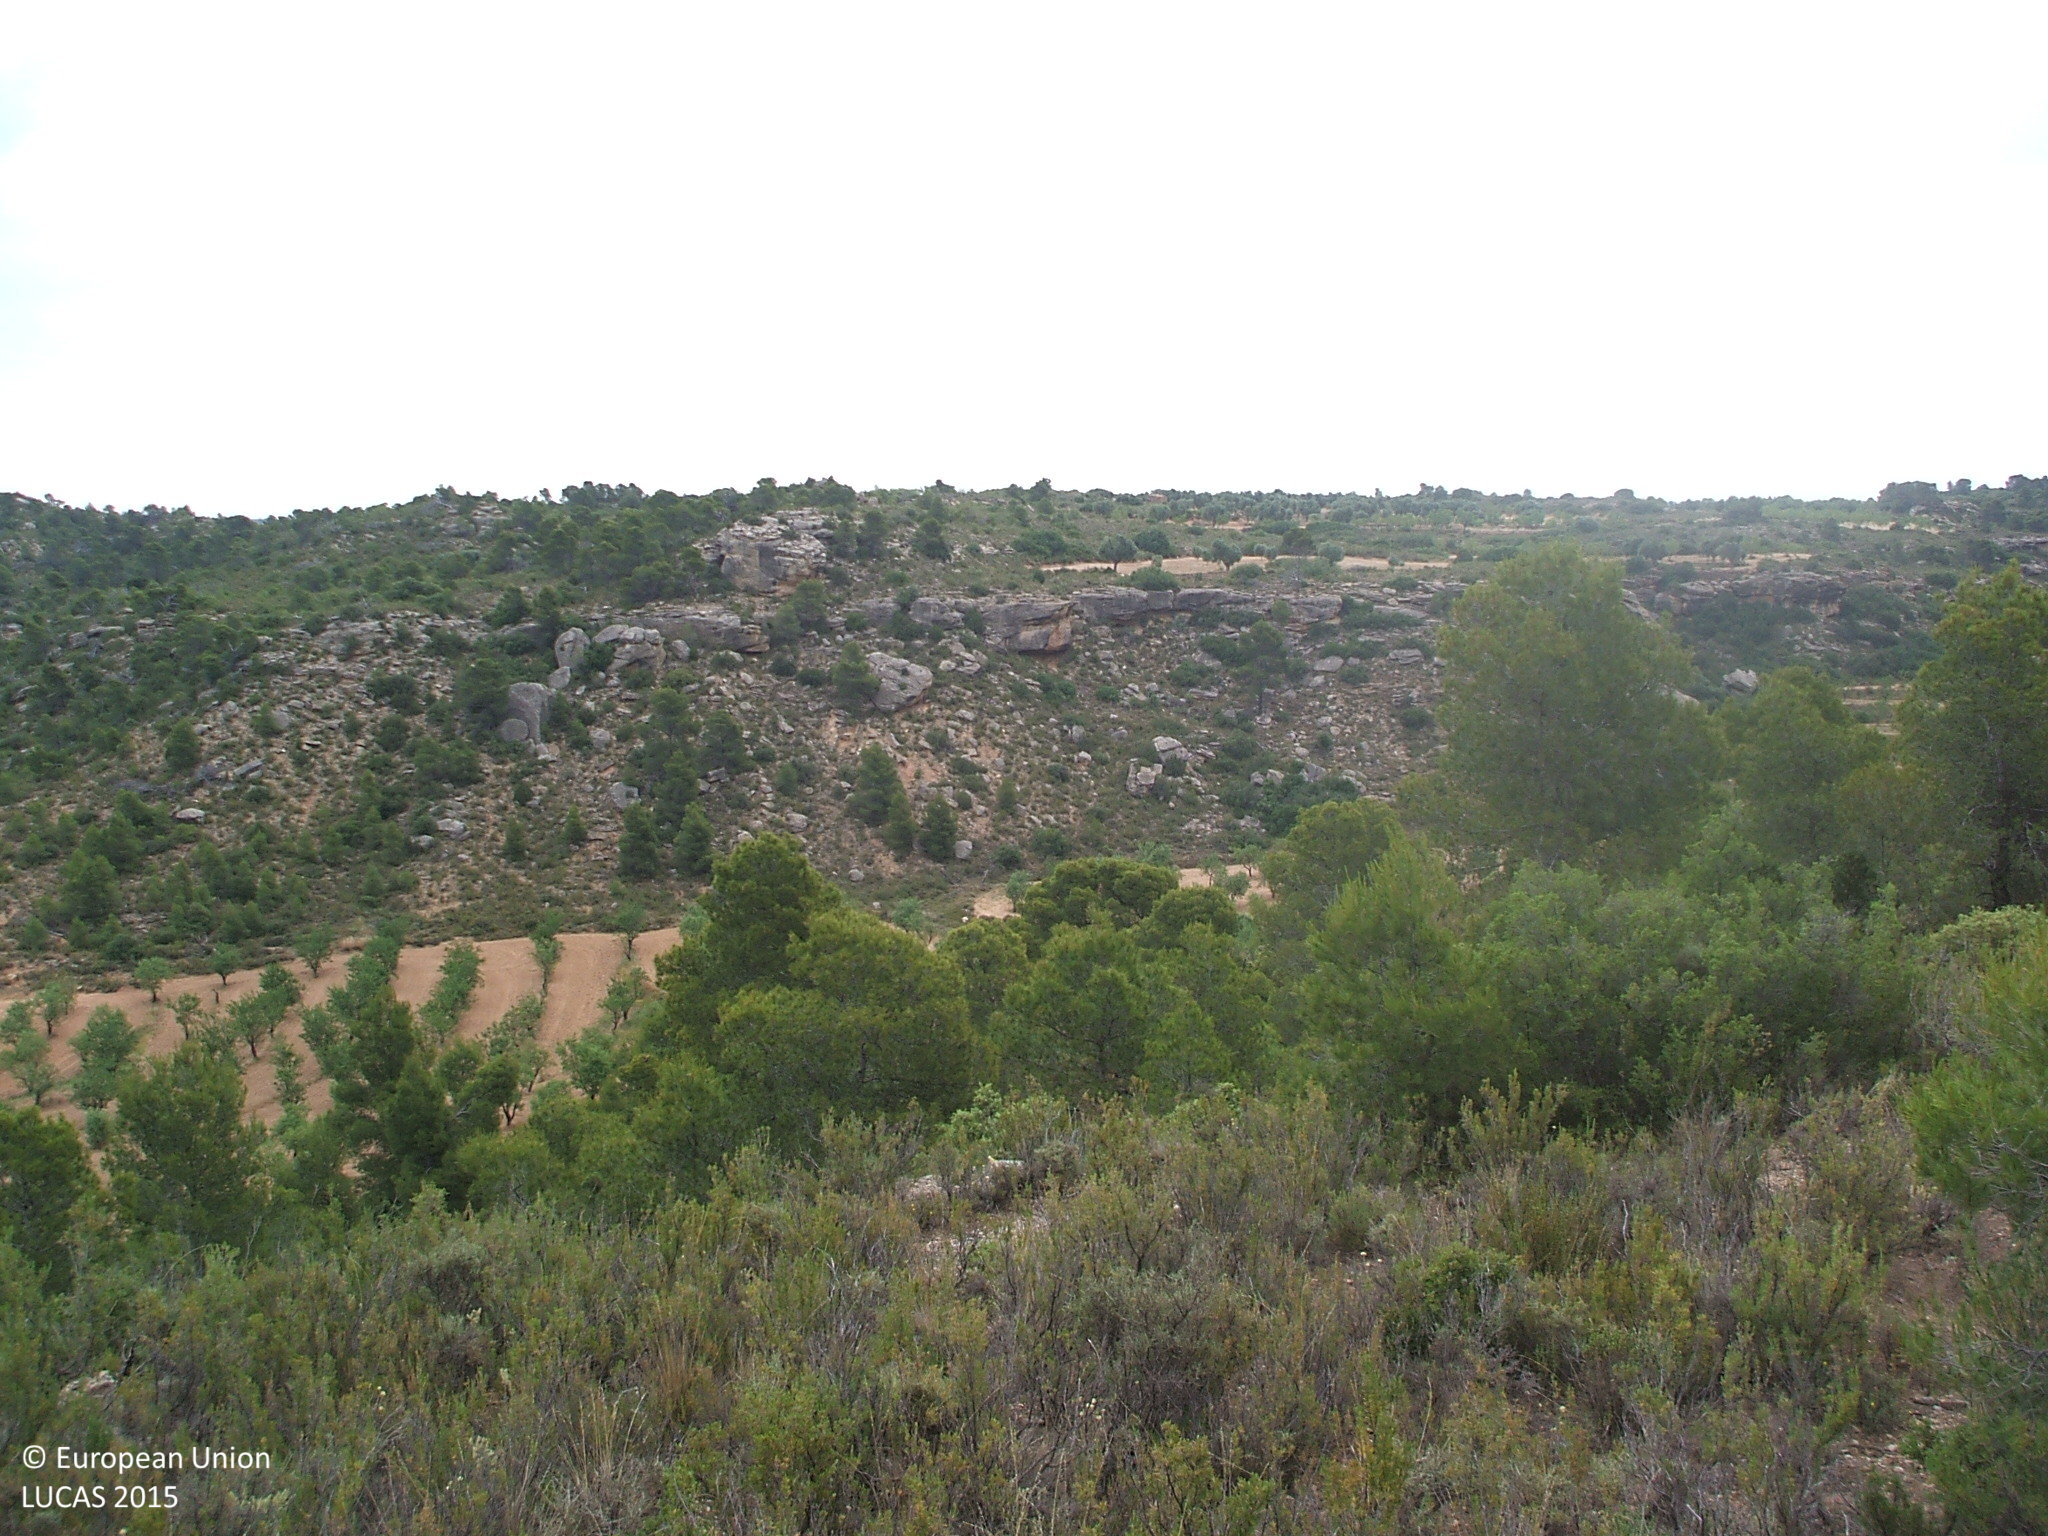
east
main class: Shrubland
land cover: Shrubland with sparse tree cover
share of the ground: > 75 %
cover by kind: shrubs 95 %, coniferous forest trees 5 %
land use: Semi-natural and natural areas not in use
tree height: > 5 m
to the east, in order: Shrubland with sparse tree cover; Rock outcrops; Shrubland with sparse tree cover; Olive groves; Shrubland with sparse tree cover; Tracks; Shrubland with sparse tree cover; Tracks; Shrubland with sparse tree cover; Rock outcrops; Shrubland without tree cover; Olive groves; Dry stone walls; Grass margins; Olive groves; Dry stone walls; Grass margins; Olive groves; Dry stone walls; Grass margins; Olive groves
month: June
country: ES
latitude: 41.0239
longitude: -0.0602
